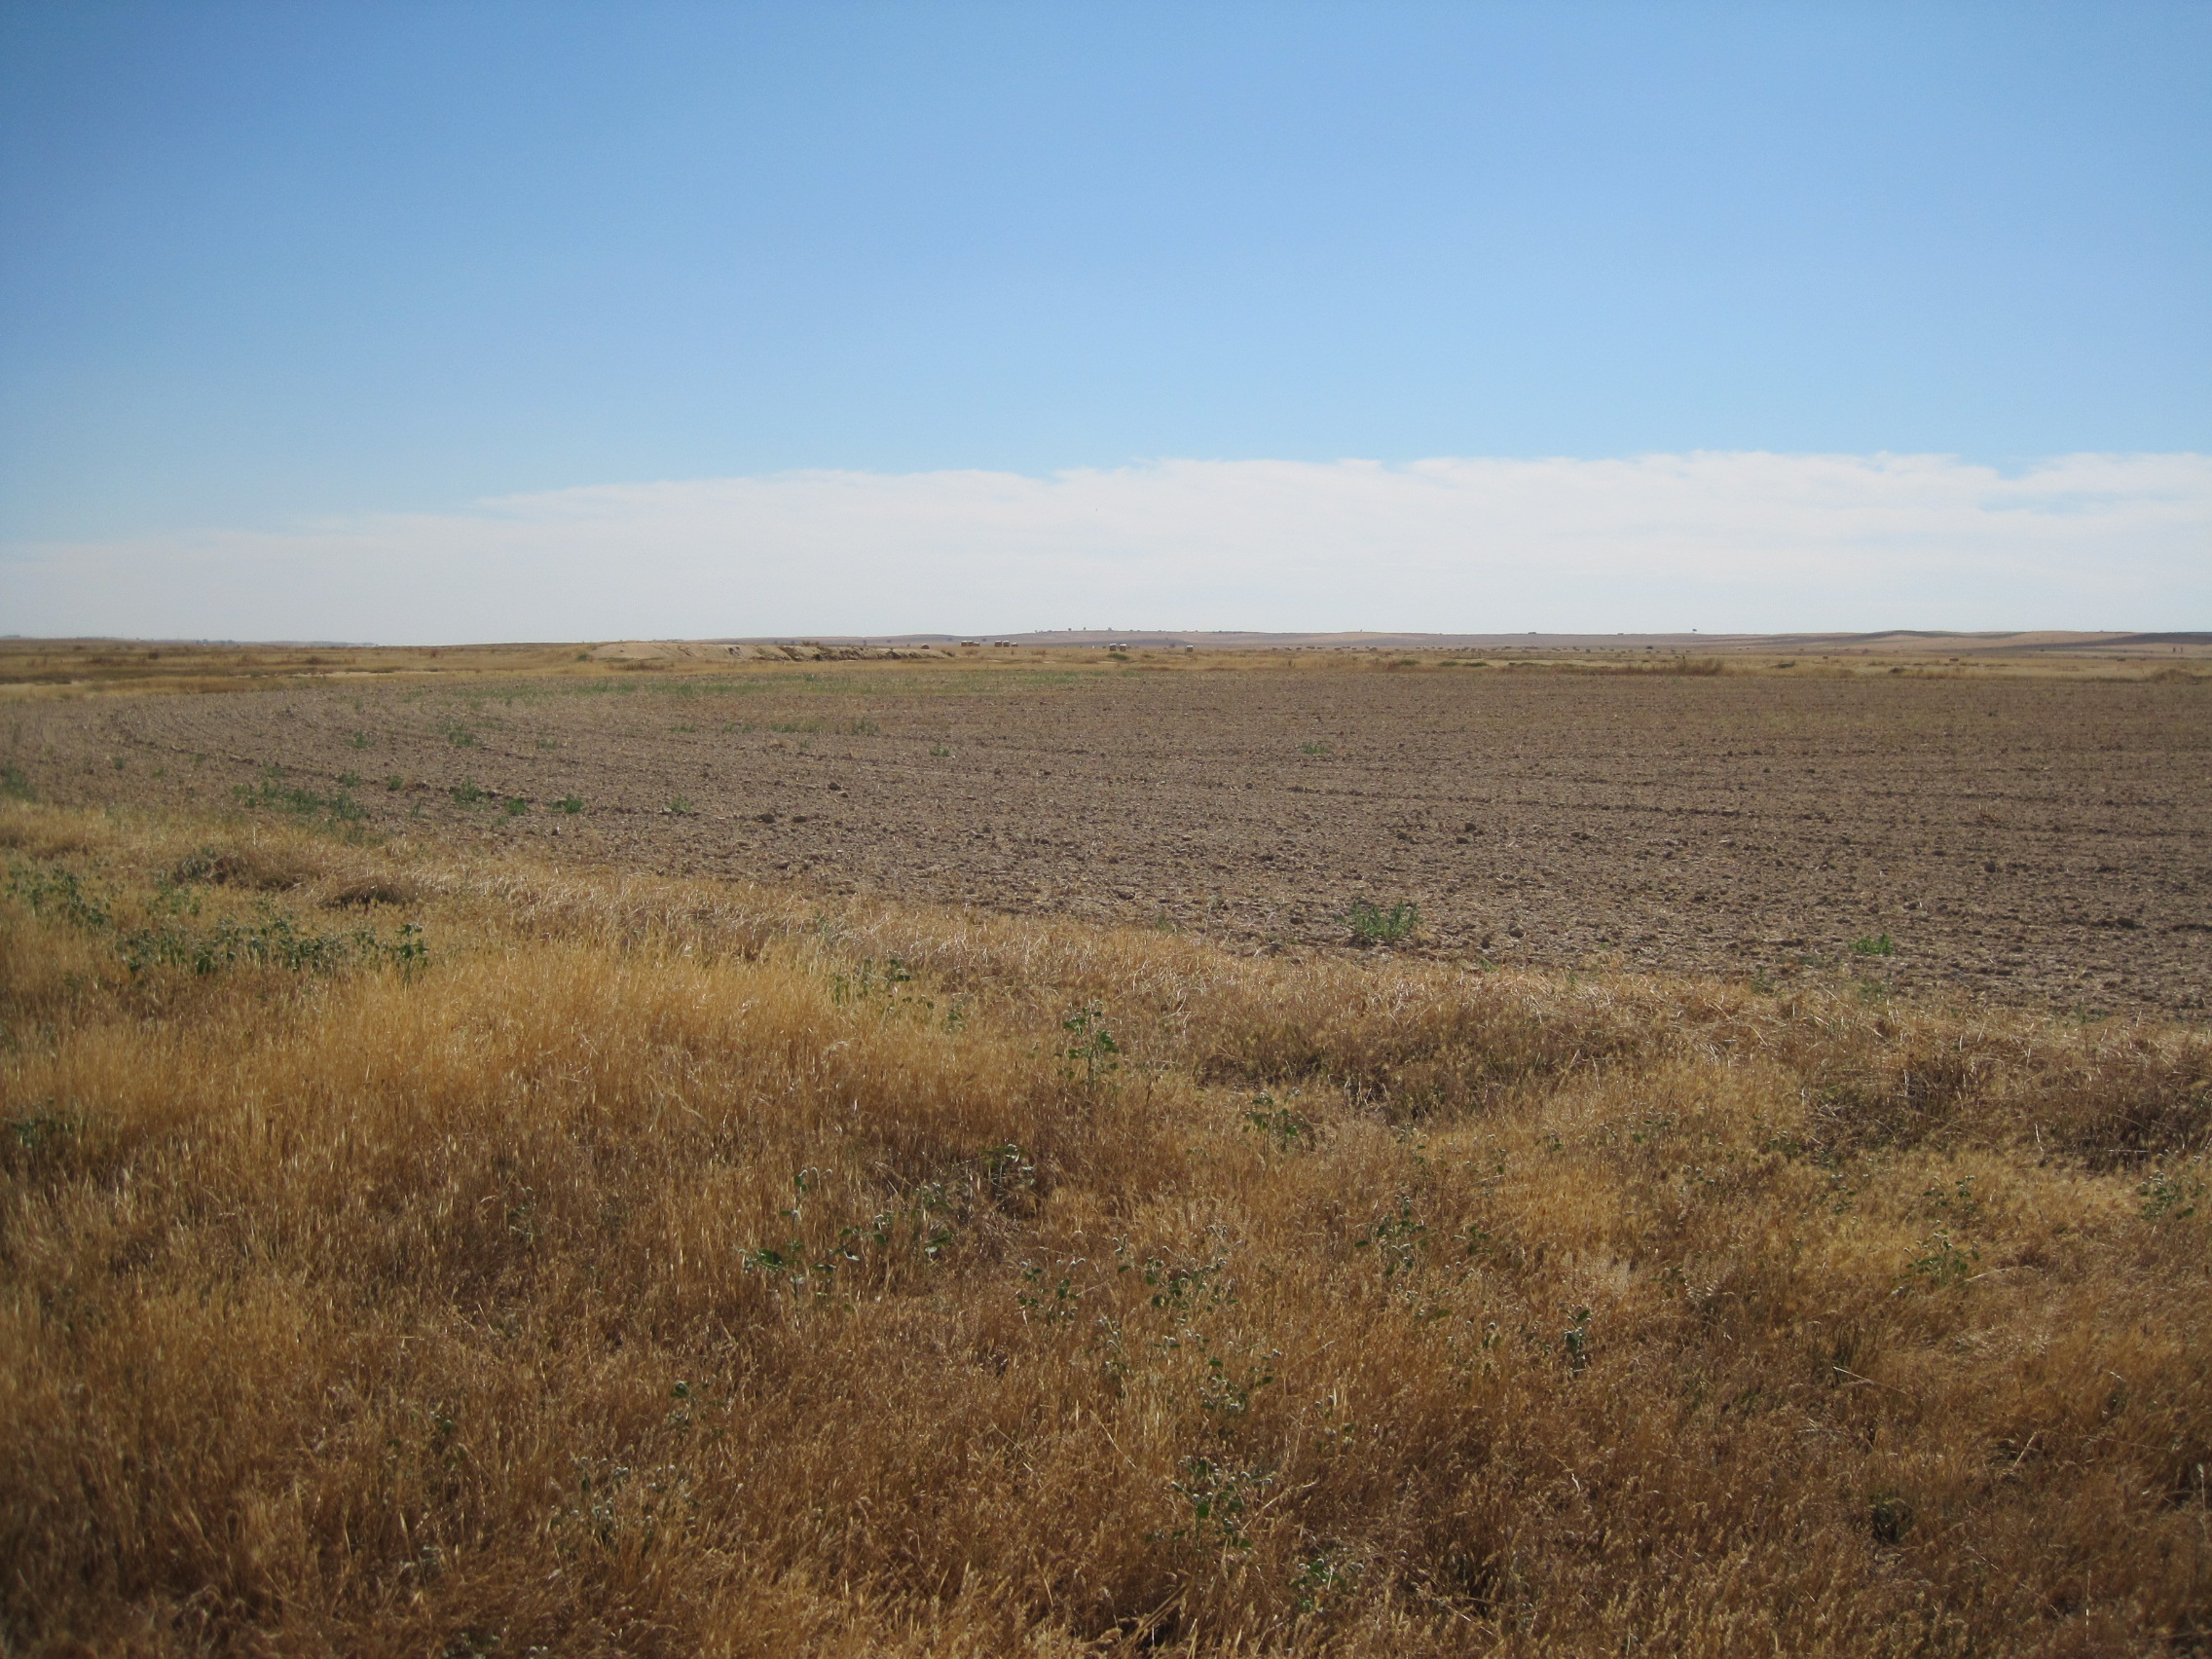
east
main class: Grassland
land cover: Spontaneously vegetated surfaces
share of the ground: > 75 %
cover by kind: herbaceous plants 100 %
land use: Semi-natural and natural areas not in use
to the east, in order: Spontaneously vegetated surfaces; Other bare soil; Spontaneously vegetated surfaces; Ditches and canals; Spontaneously vegetated surfaces; Inland salty water bodies; Sand; Spontaneously vegetated surfaces
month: July
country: ES
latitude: 41.8463
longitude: -5.5637
